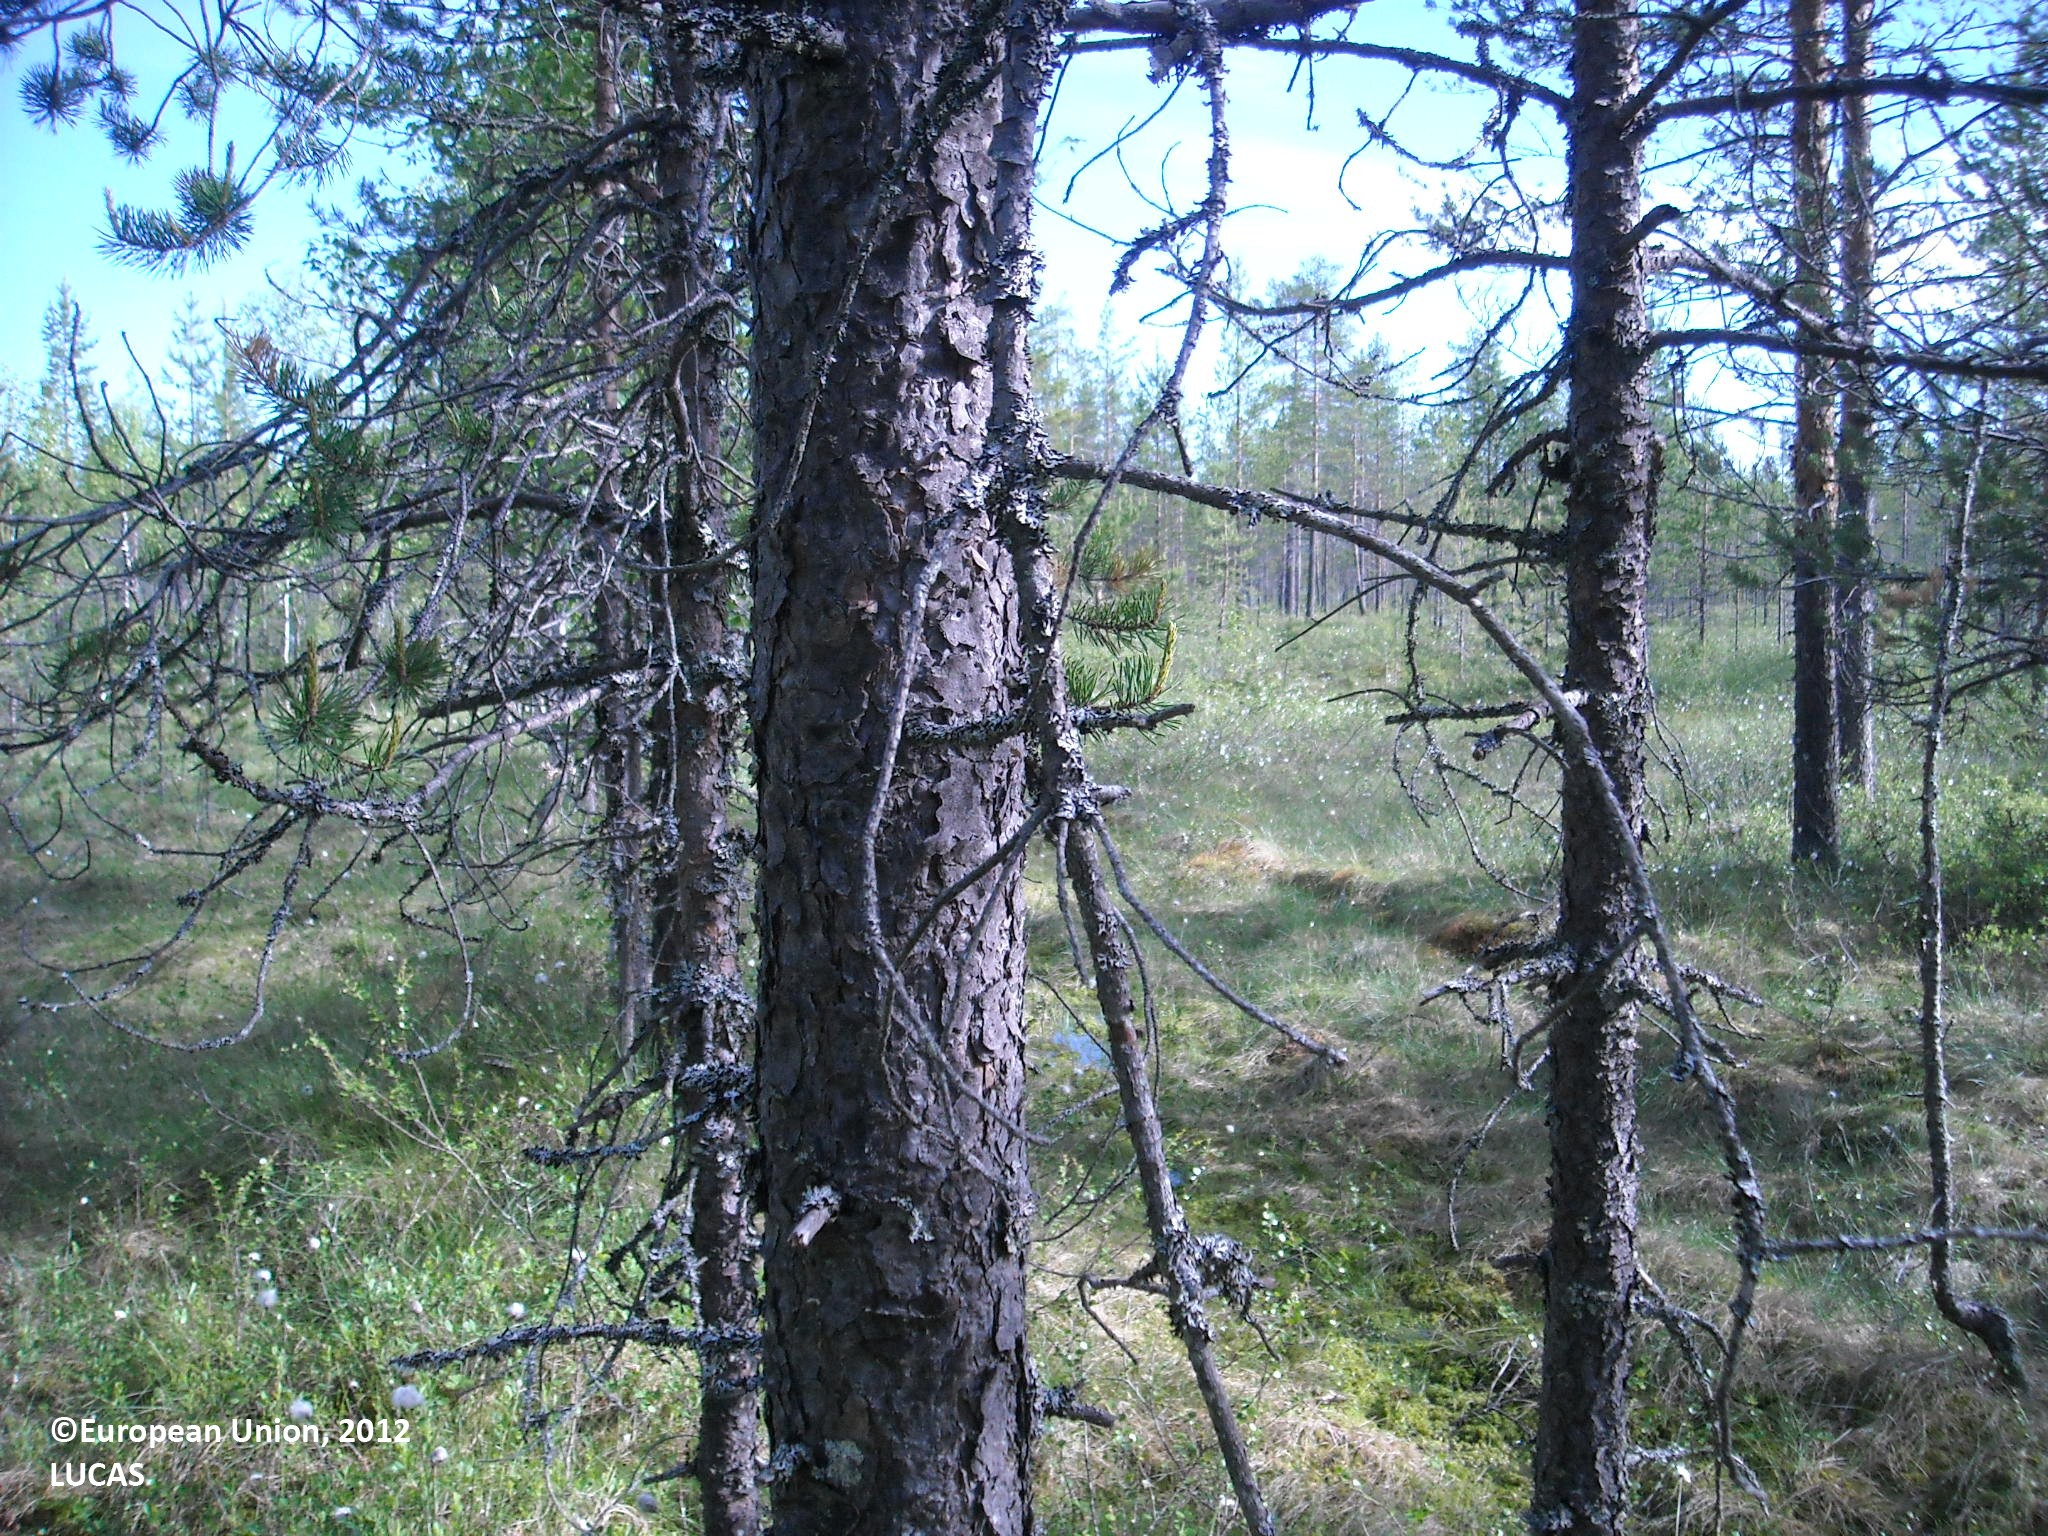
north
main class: Woodland
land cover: Pine dominated coniferous woodland
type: mire and swamp forests
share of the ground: > 75 %
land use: Forestry
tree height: > 5 m
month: July
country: FI
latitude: 64.6505
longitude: 27.7542
